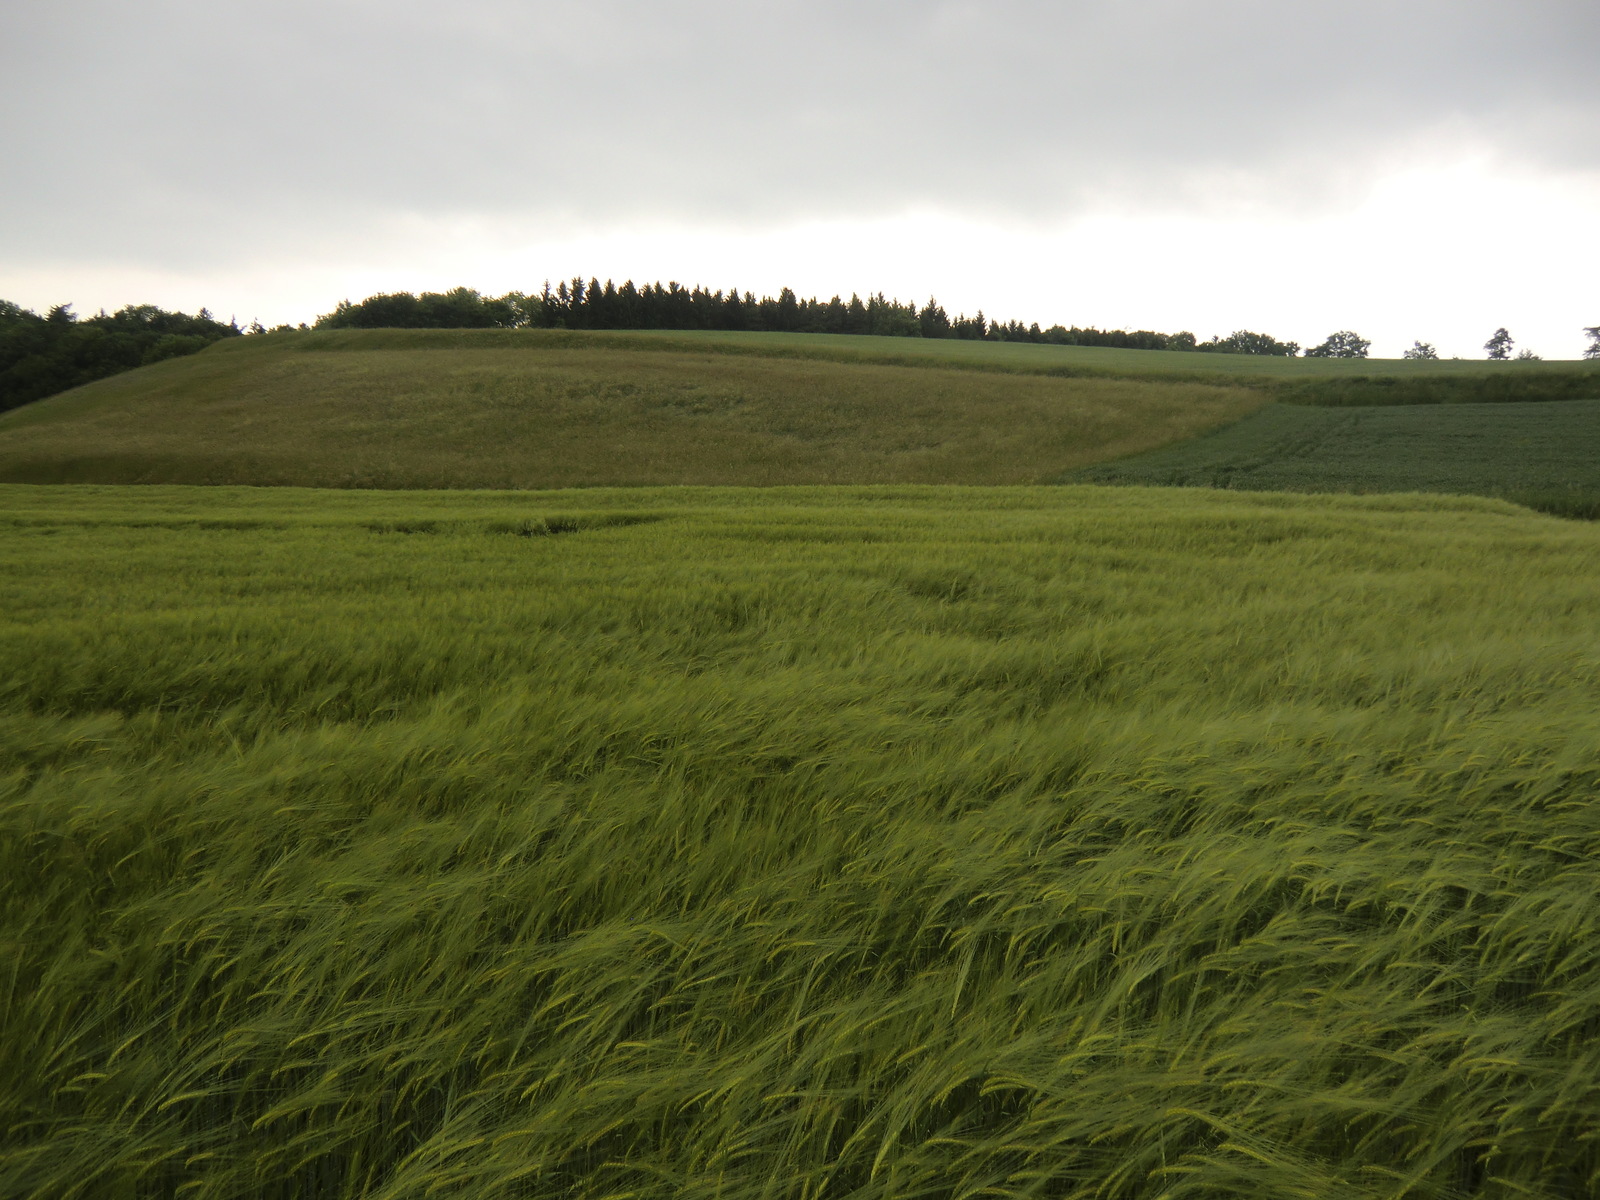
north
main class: Cropland
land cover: Barley
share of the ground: > 75 %
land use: Agriculture (excluding fallow land and kitchen gardens)
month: May
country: AT
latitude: 48.1431
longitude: 15.4451
